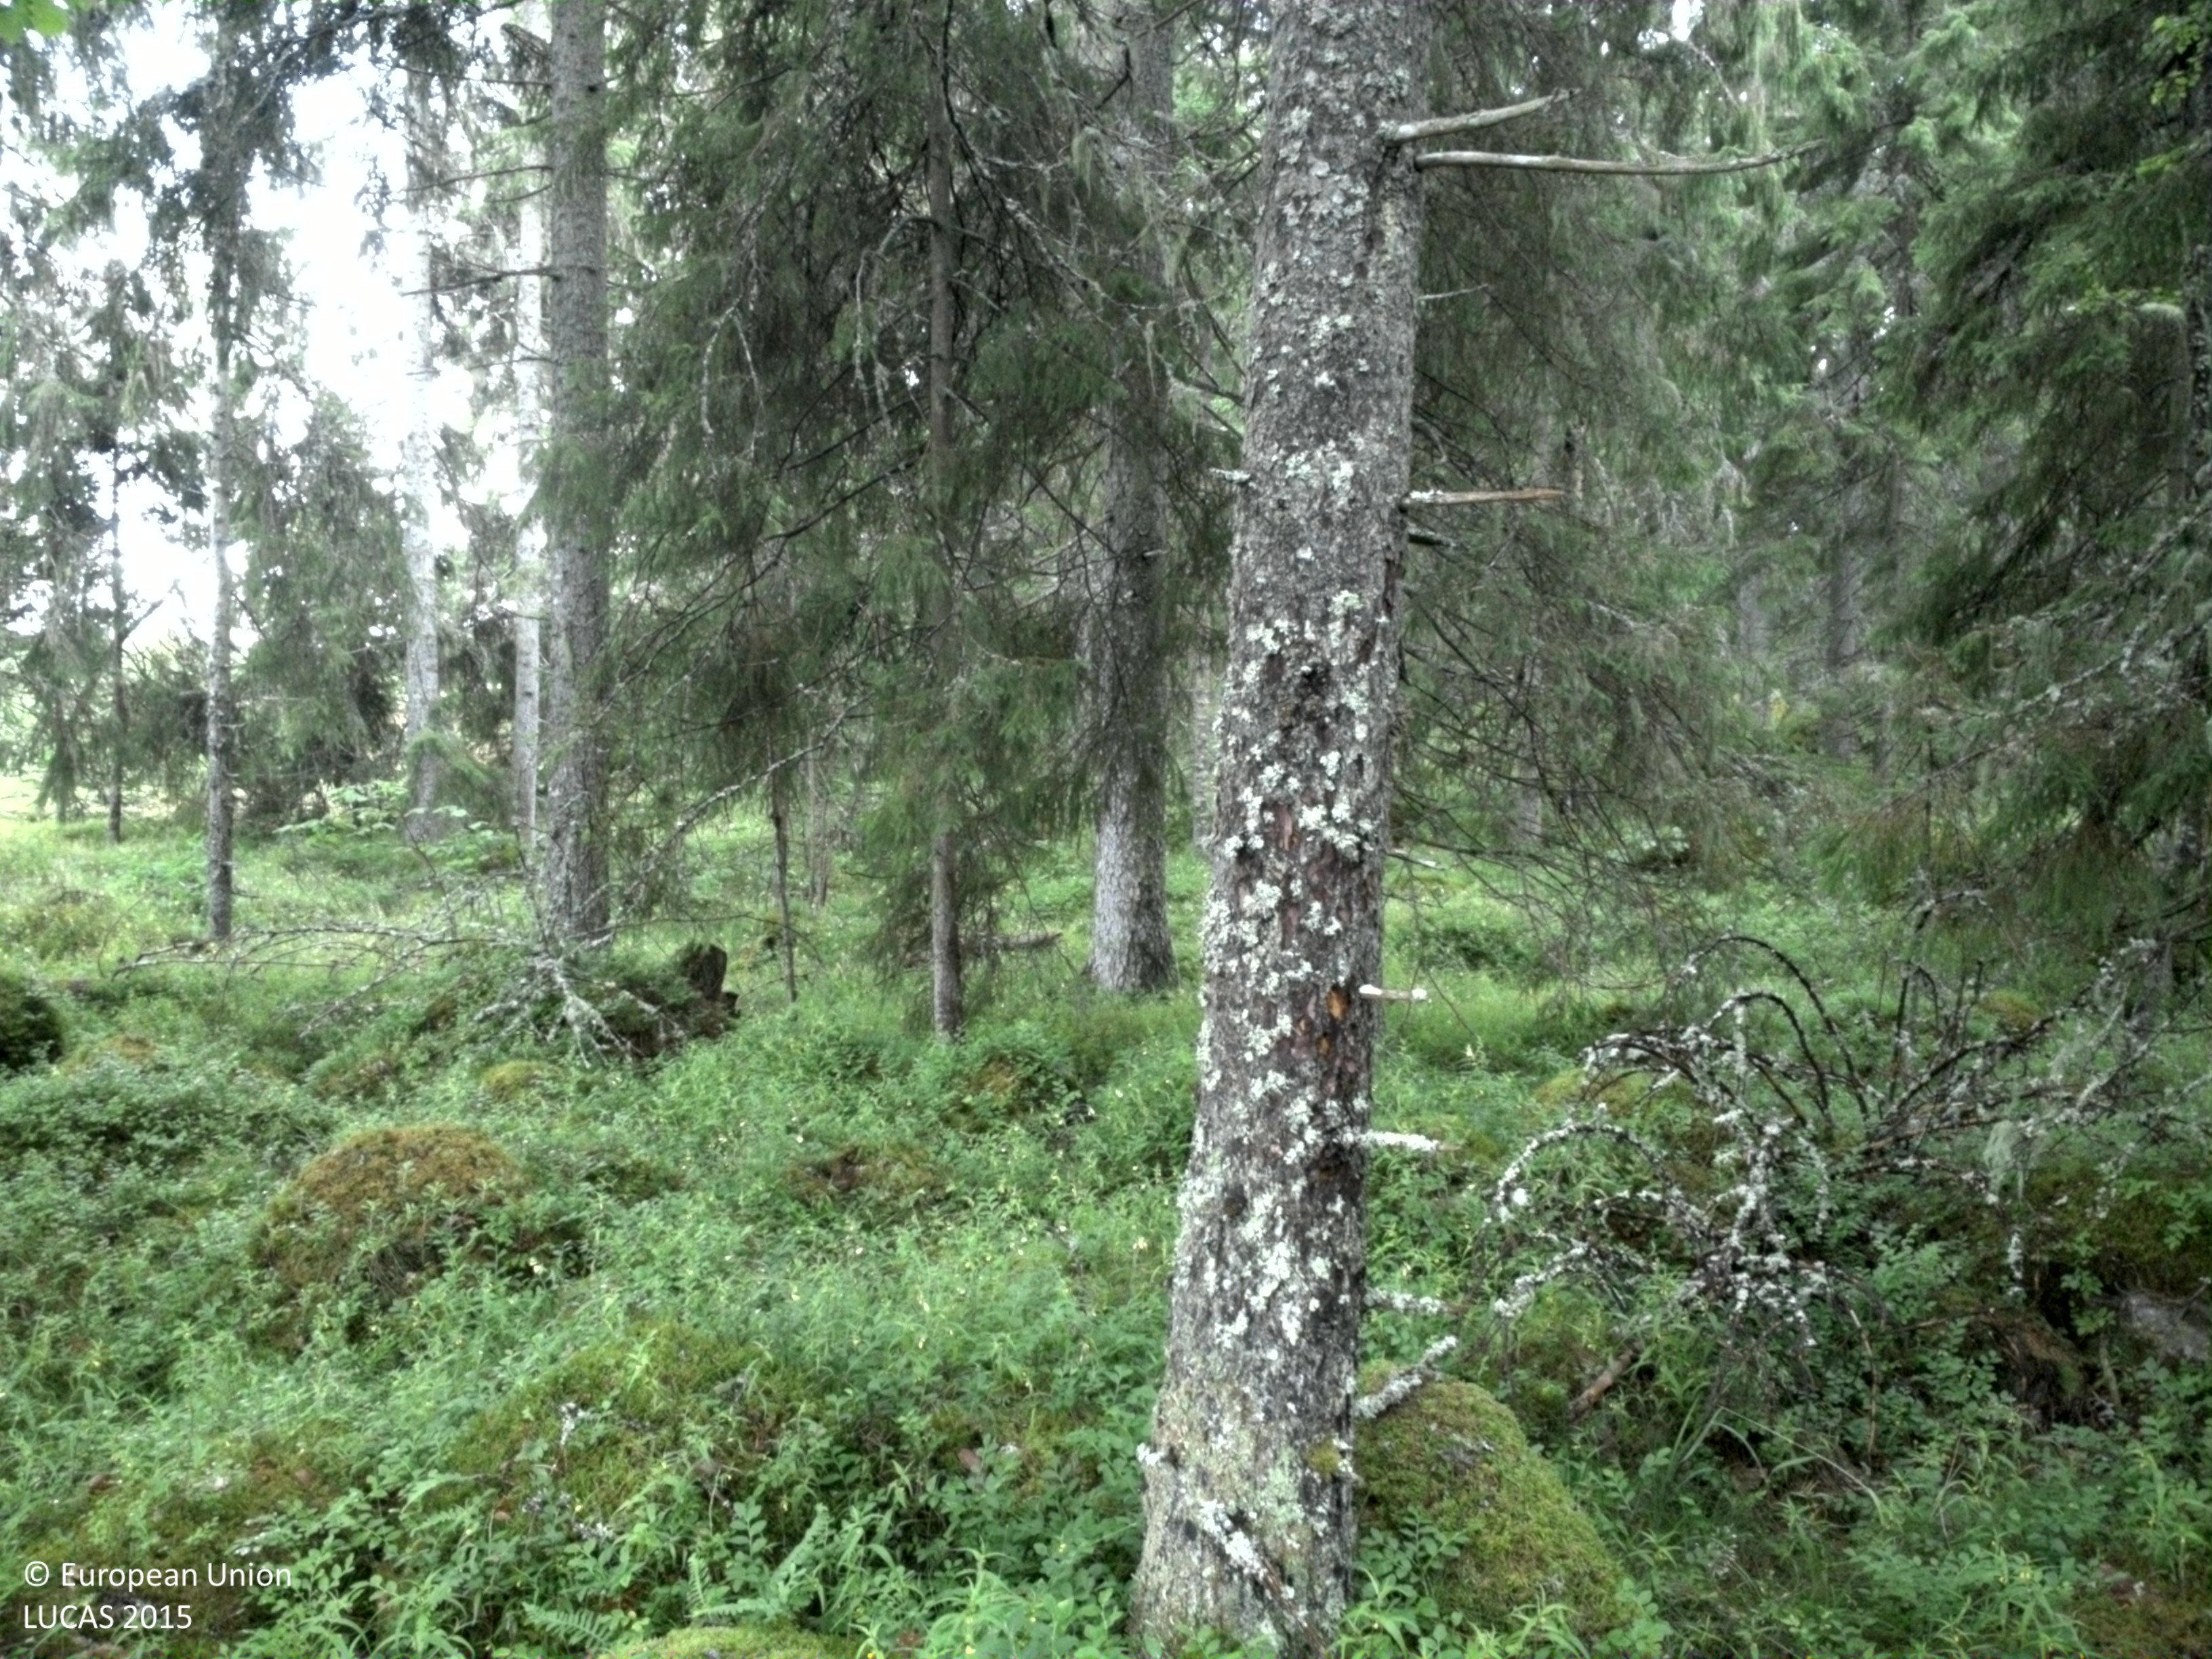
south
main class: Woodland
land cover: Spruce dominated coniferous woodland
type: boreal forest
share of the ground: 50 - 75 %
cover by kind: coniferous forest trees 55 %, shrubs 30 %, herbaceous plants 10 %, lichens and mosses 5 %
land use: Amenities, museums, leisure
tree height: > 5 m
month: July
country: SE
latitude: 59.8798
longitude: 18.6279
